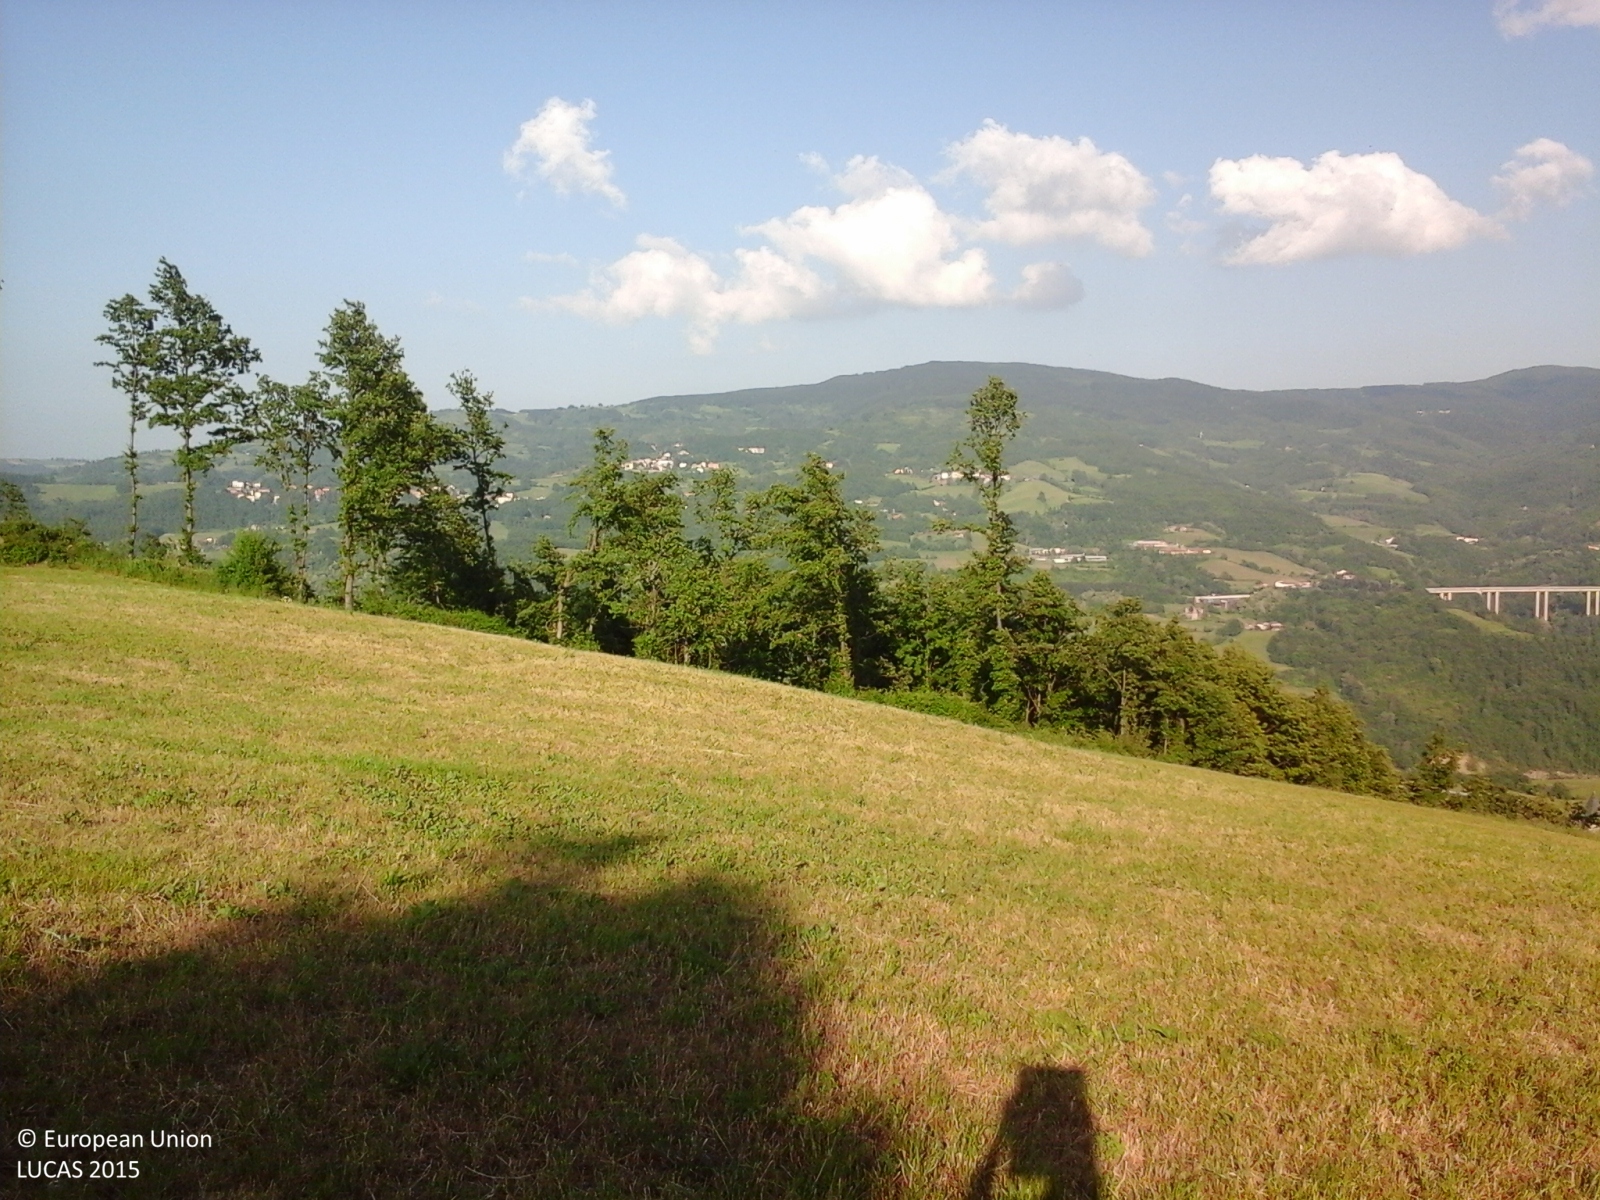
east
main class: Grassland
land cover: Grassland without tree/shrub cover
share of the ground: > 75 %
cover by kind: herbaceous plants 100 %
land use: Agriculture (excluding fallow land and kitchen gardens)
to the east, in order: Grassland without tree/shrub cover; Tracks; Broadleaved woodland; Paved roads, cycling and walking lanes; Broadleaved woodland; Grassland without tree/shrub cover
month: May
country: IT
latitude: 44.1814
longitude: 11.1855
